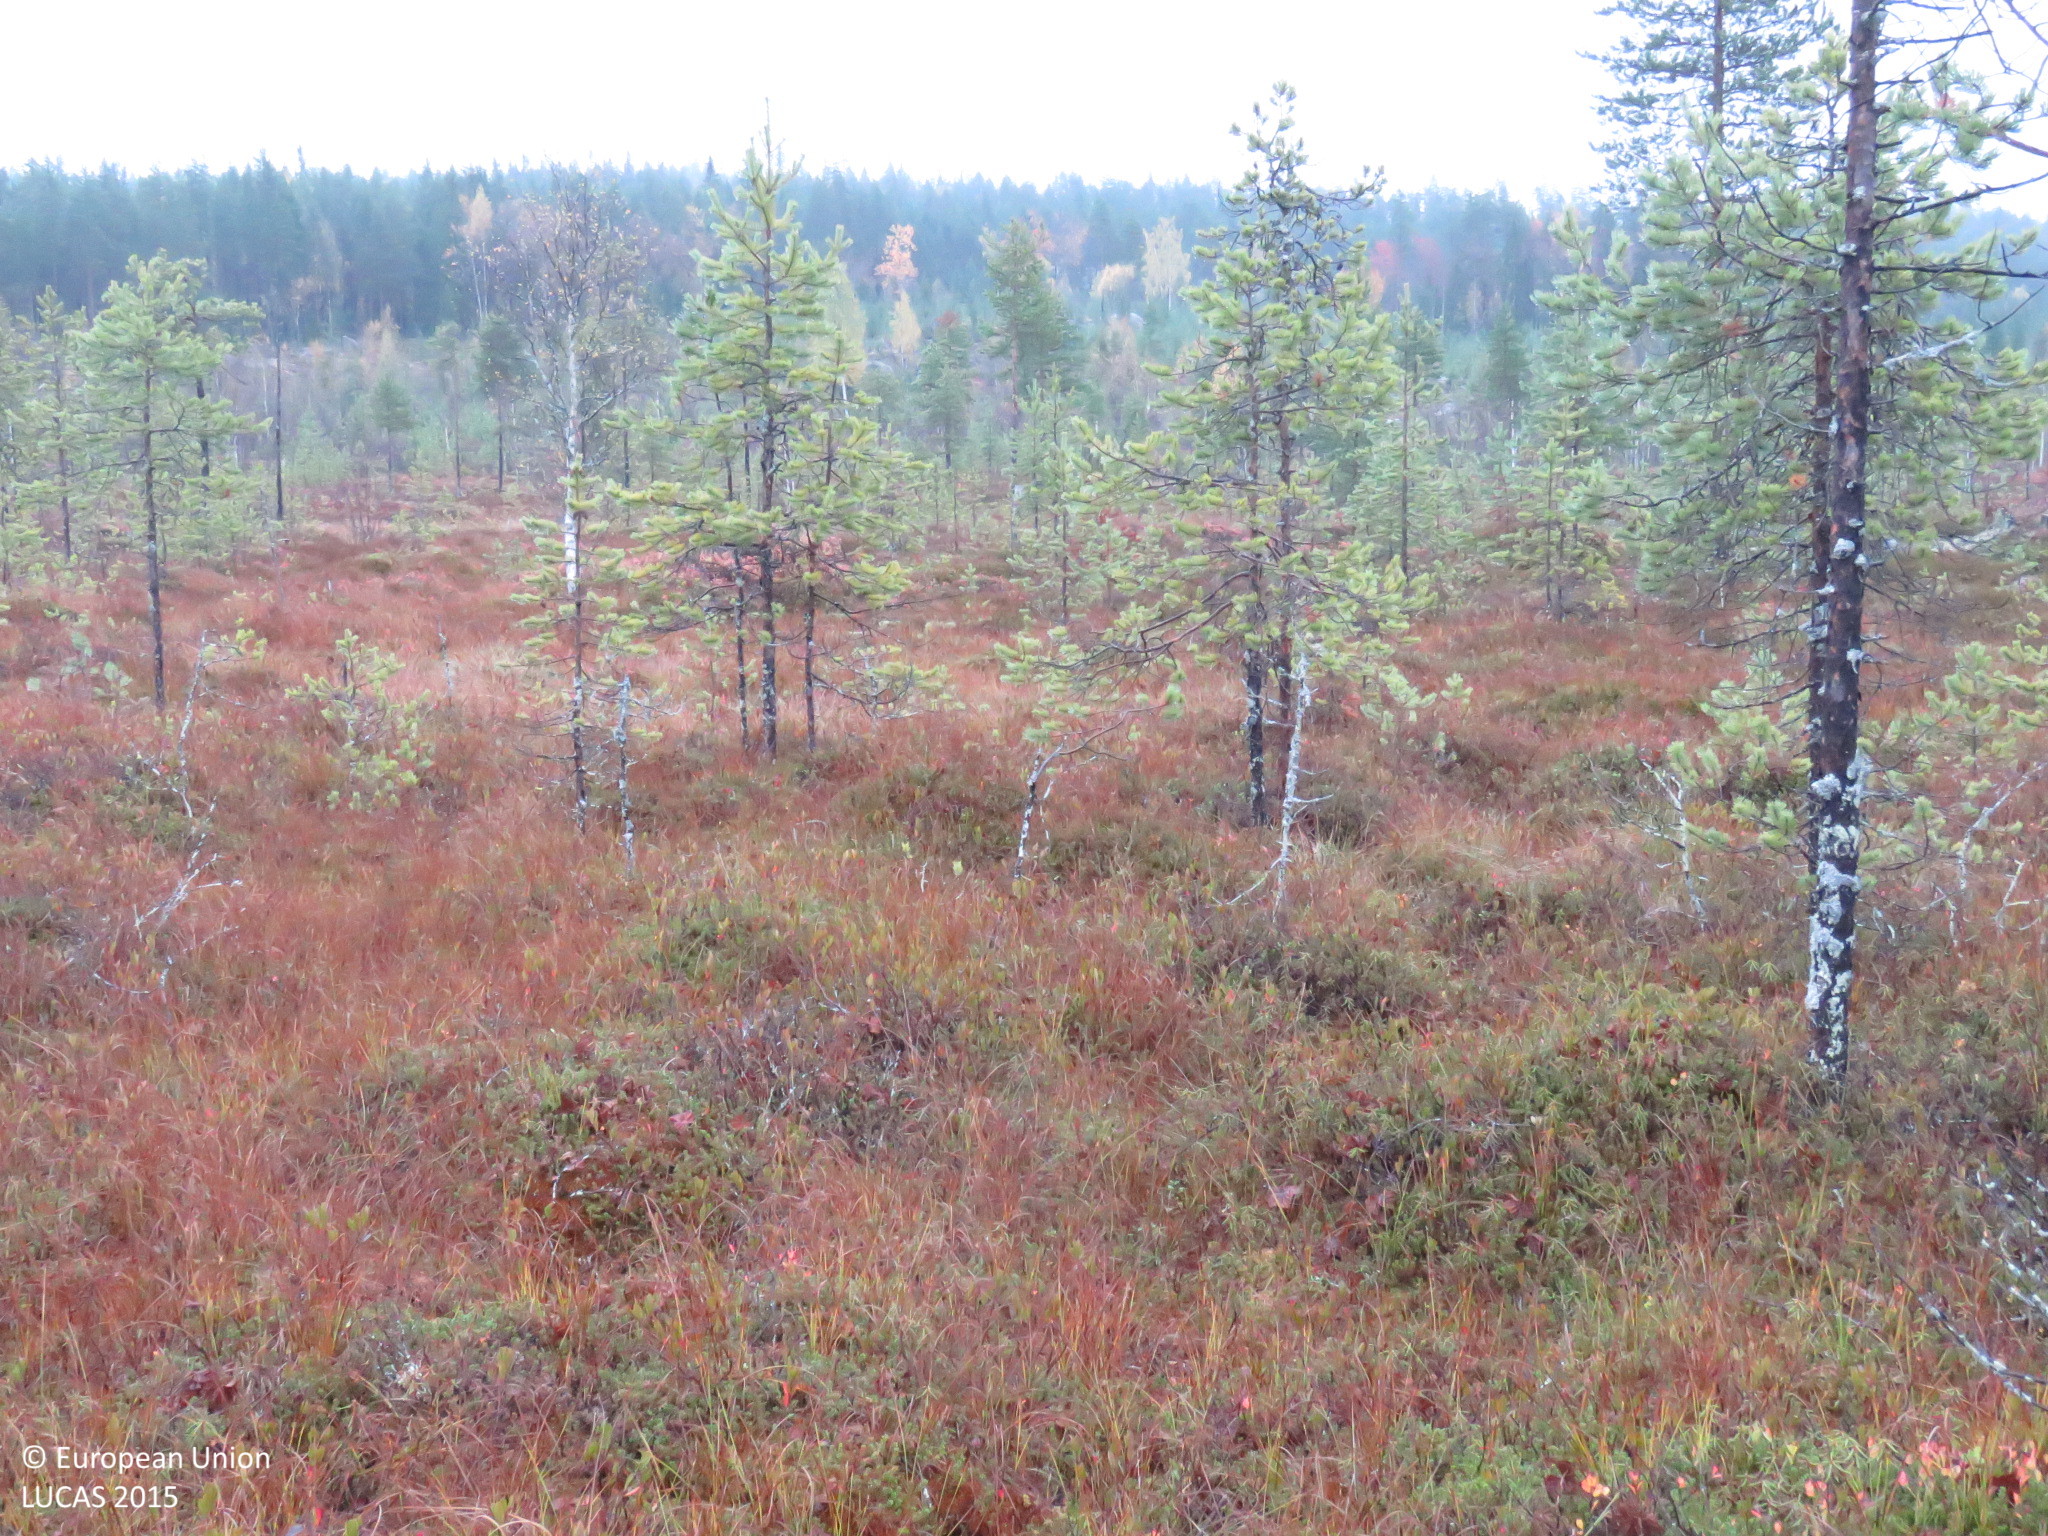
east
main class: Woodland
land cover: Pine dominated coniferous woodland
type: mire and swamp forests
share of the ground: 25 - 50 %
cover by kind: coniferous forest trees 40 %, herbaceous plants 30 %, shrubs 25 %, lichens and mosses 5 %
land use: Semi-natural and natural areas not in use
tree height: < 5 m
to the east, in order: Pine dominated coniferous woodland; Pine dominated mixed woodland; Other mixed woodland; Pine dominated mixed woodland
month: September
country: FI
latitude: 65.3096
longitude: 27.3562
